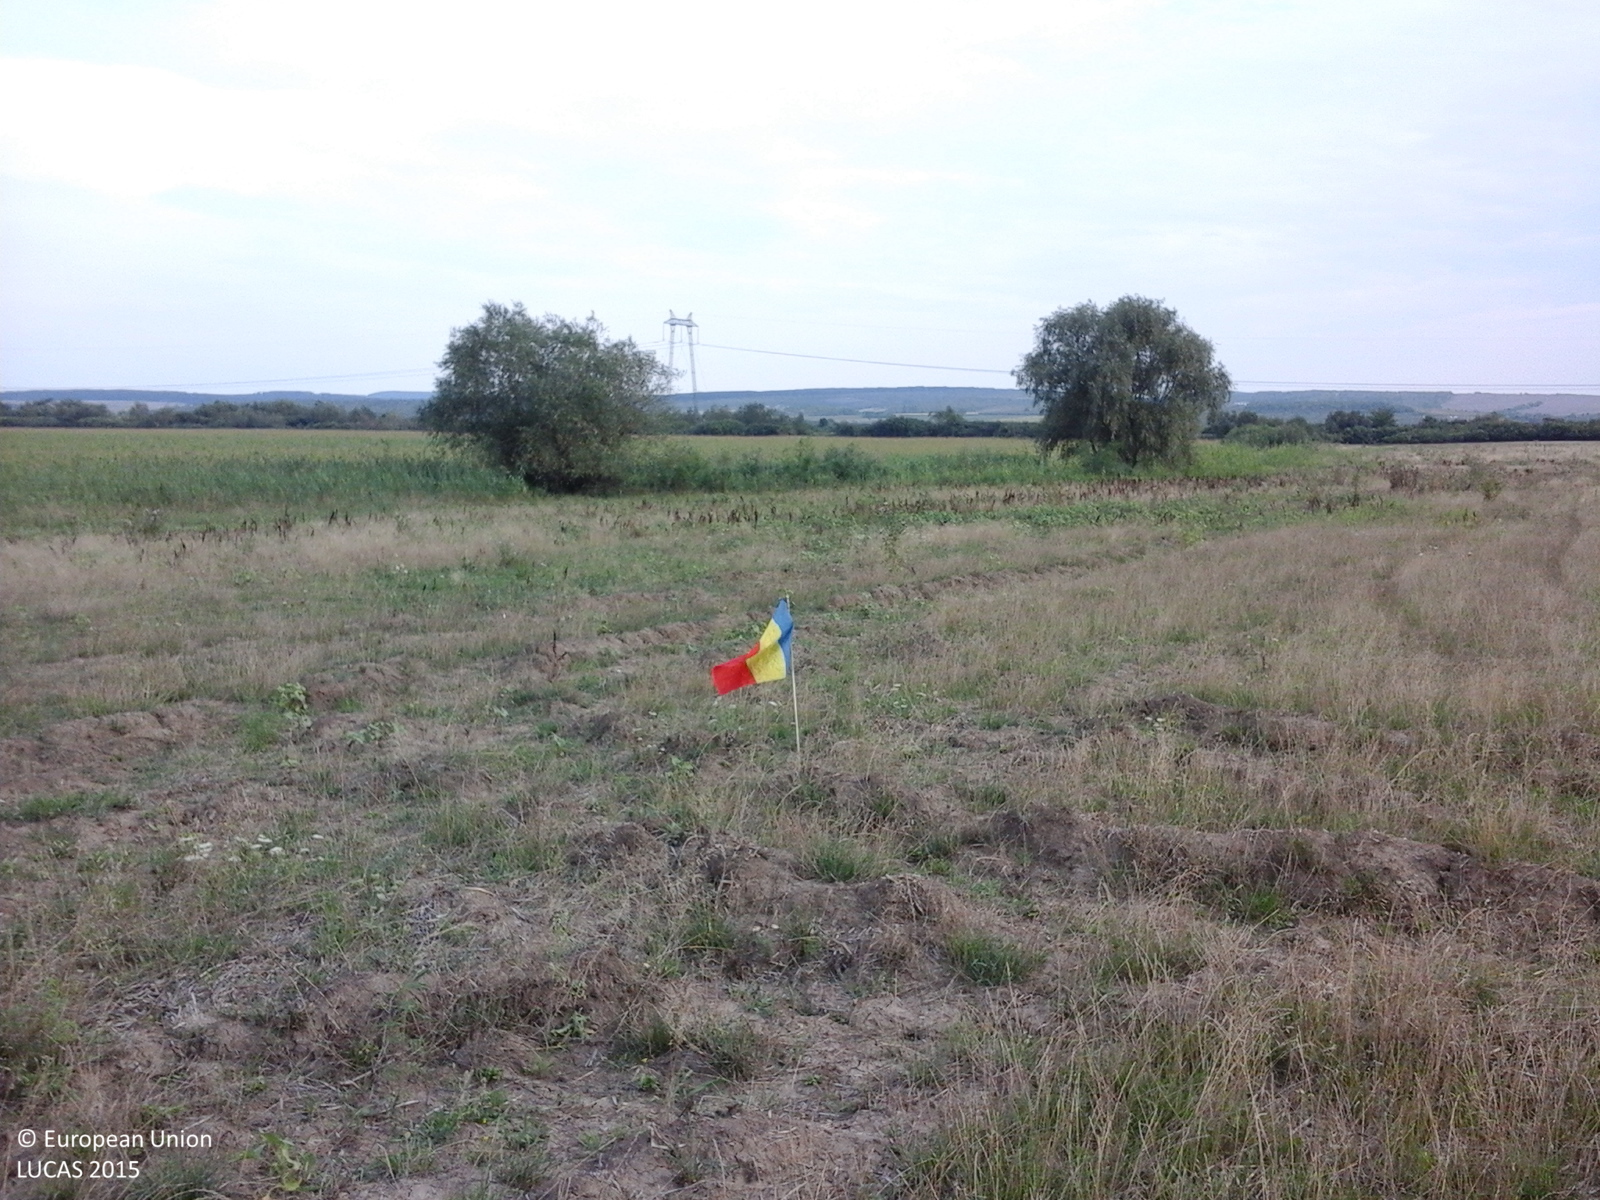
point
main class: Grassland
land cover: Spontaneously vegetated surfaces
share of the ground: > 75 %
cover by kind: herbaceous plants 90 %, consolidated bare surface 10 %
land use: Fallow land
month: August
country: RO
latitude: 46.0776
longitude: 21.6359
